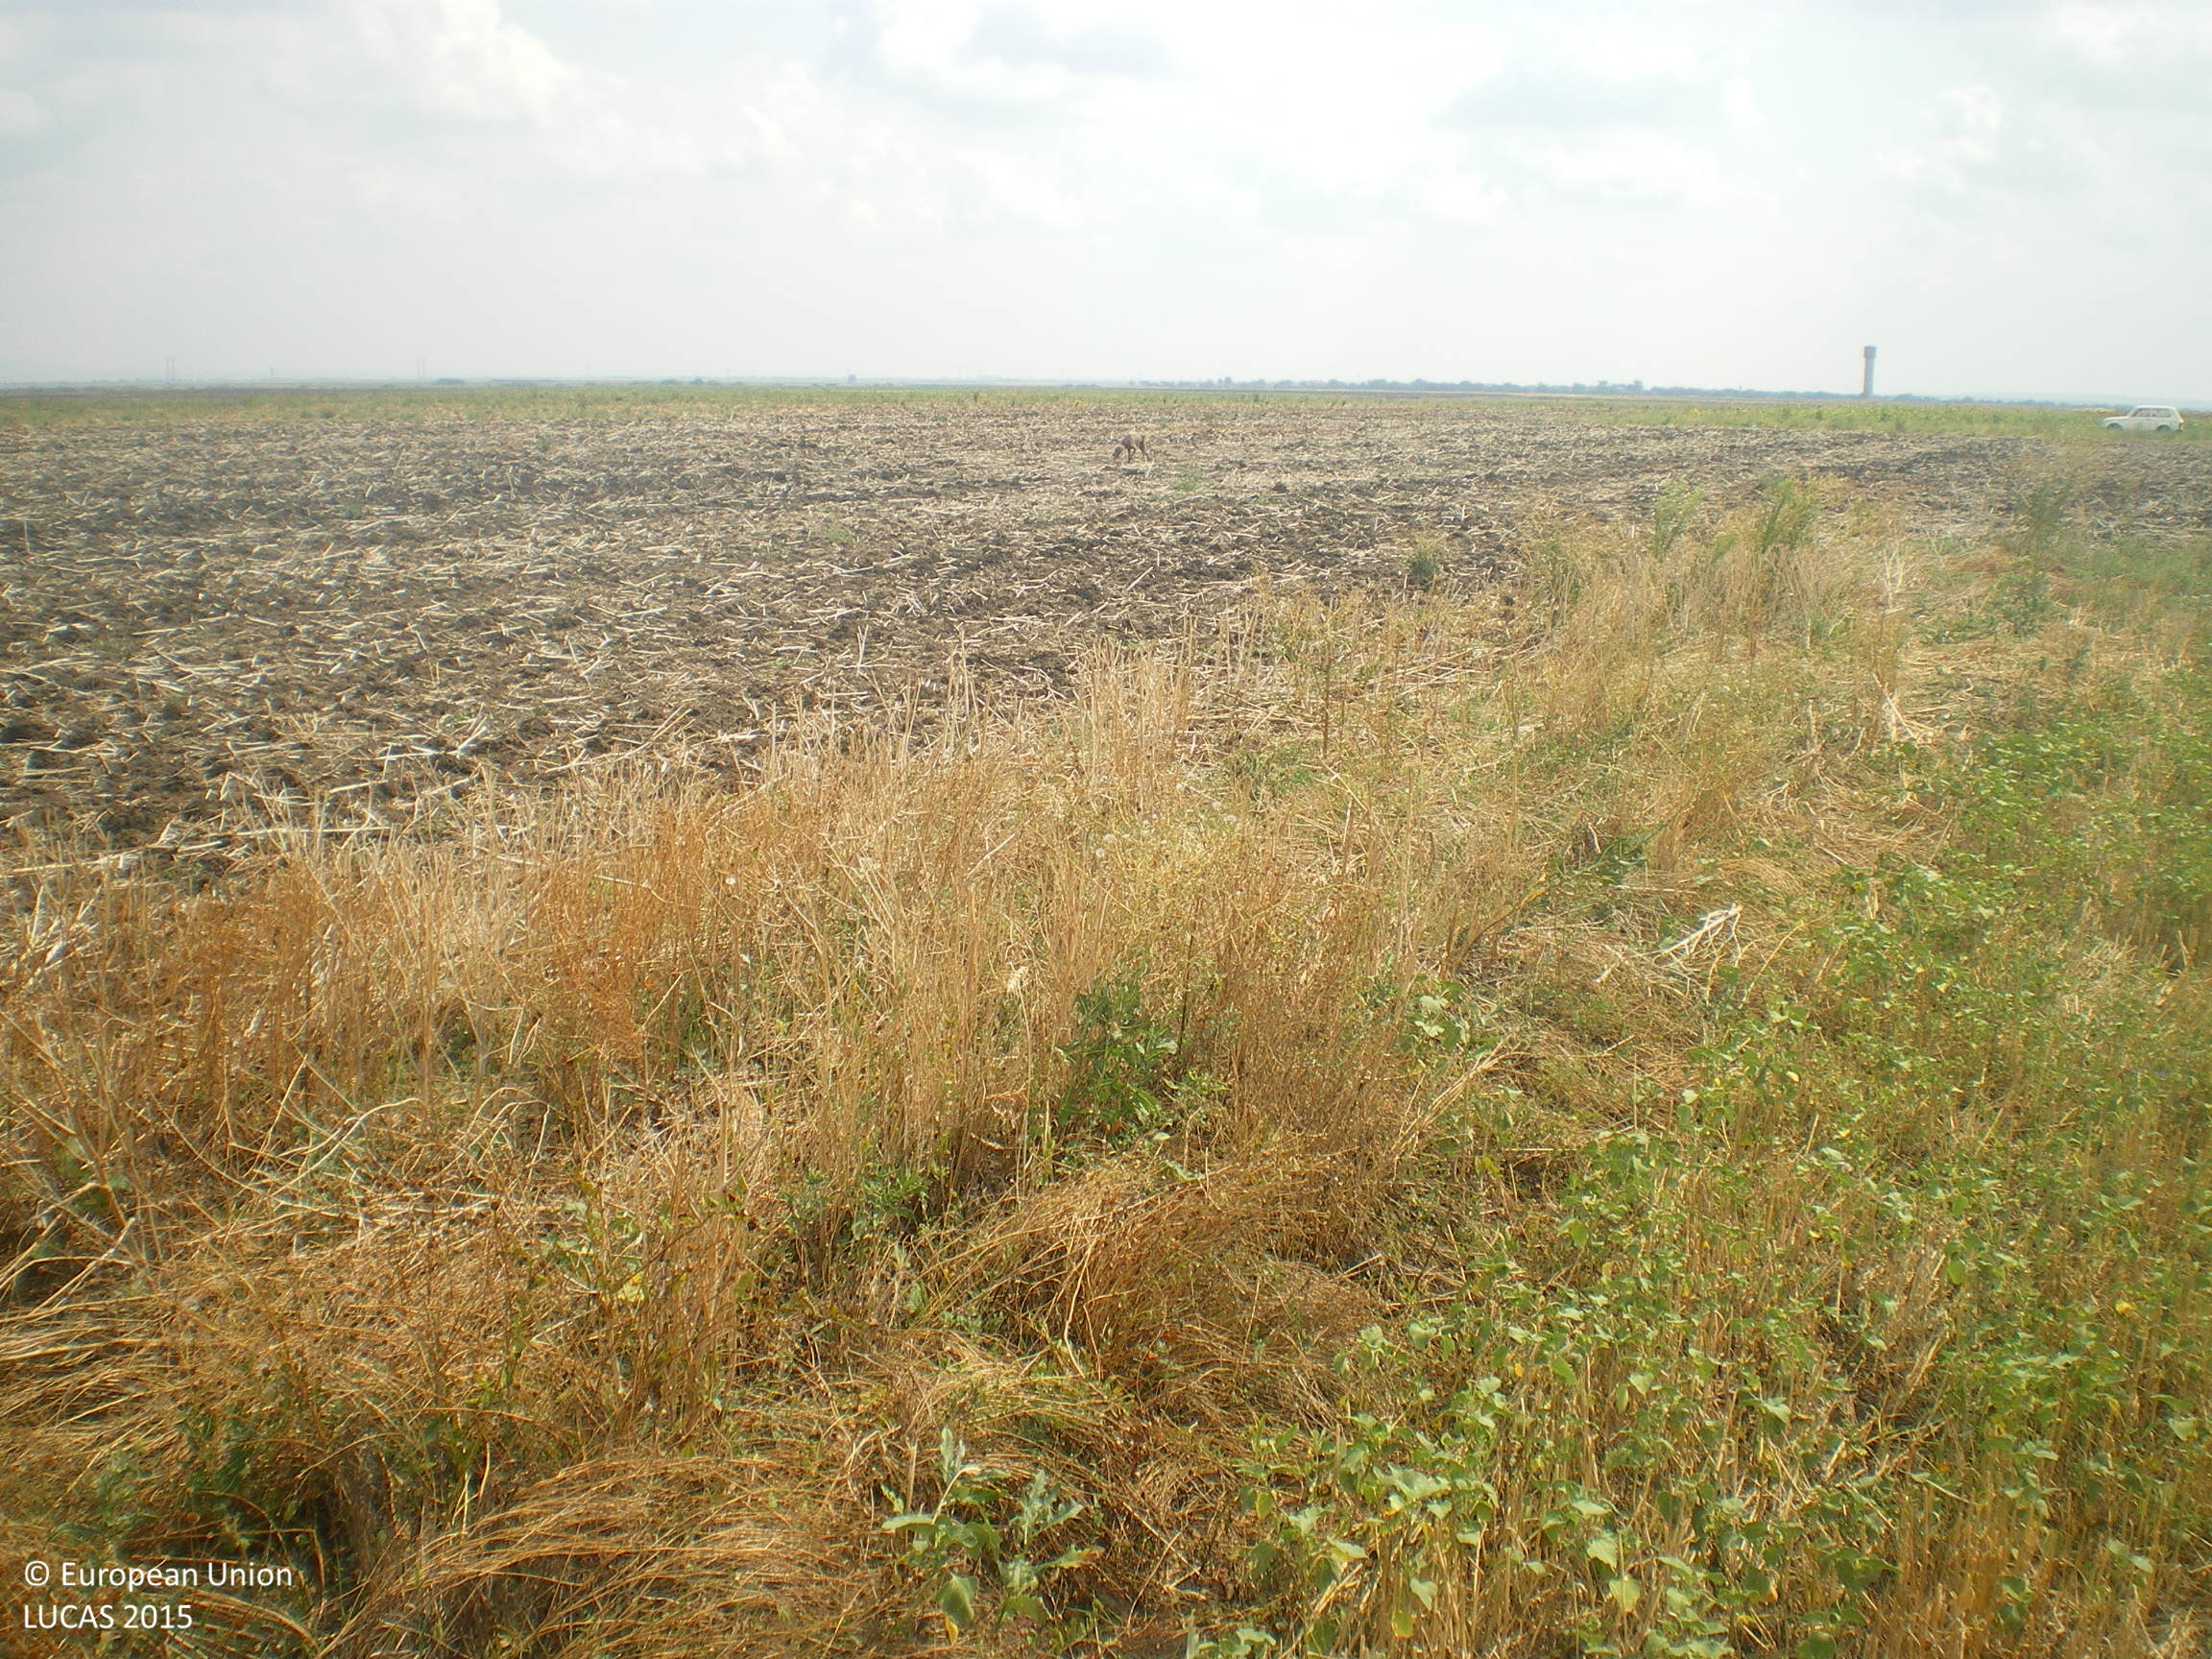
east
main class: Cropland
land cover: Common wheat
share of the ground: < 10 %
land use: Agriculture (excluding fallow land and kitchen gardens)
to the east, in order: Common wheat; Sunflower; Spontaneously vegetated surfaces
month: August
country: BG
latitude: 42.3488
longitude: 25.8693
